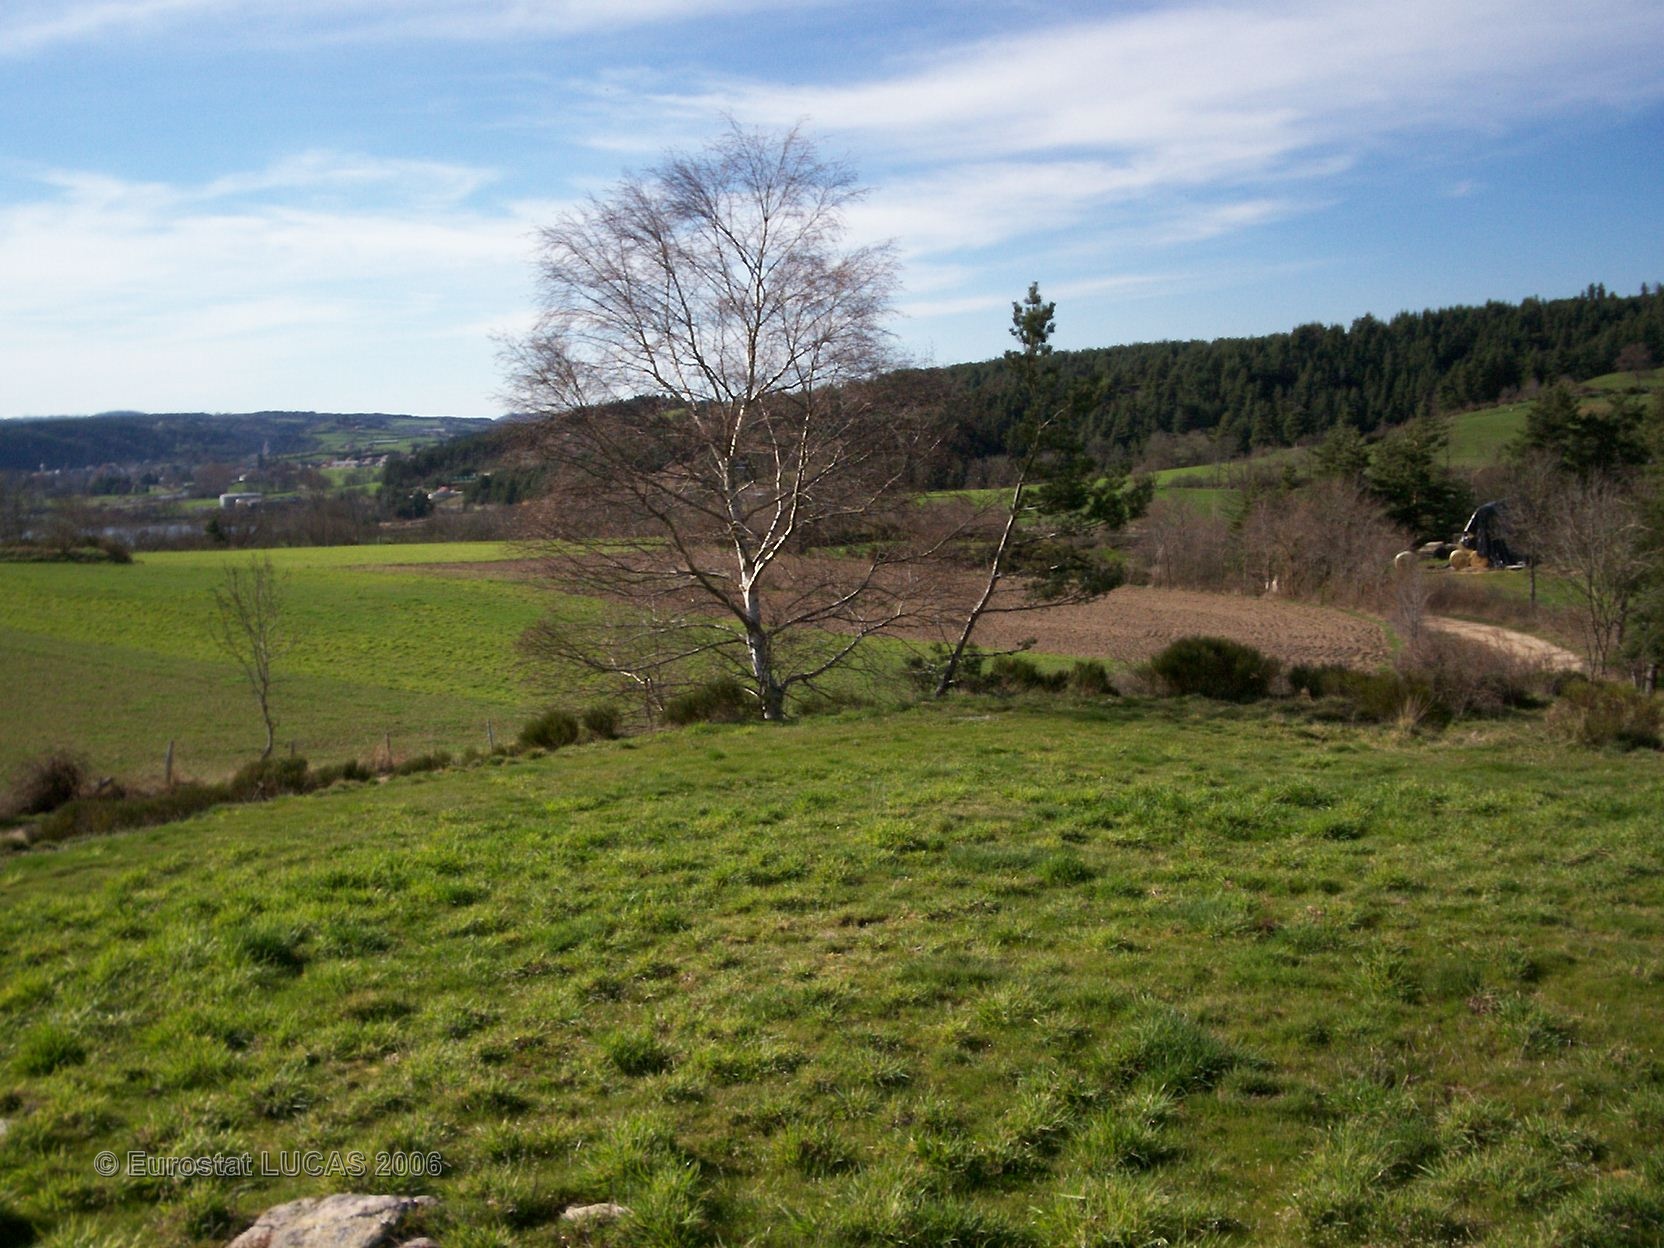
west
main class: Grassland
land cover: Grassland without tree/shrub cover
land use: Agriculture (excluding fallow land and kitchen gardens)
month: April
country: FR
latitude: 44.8434
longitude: 3.3617
